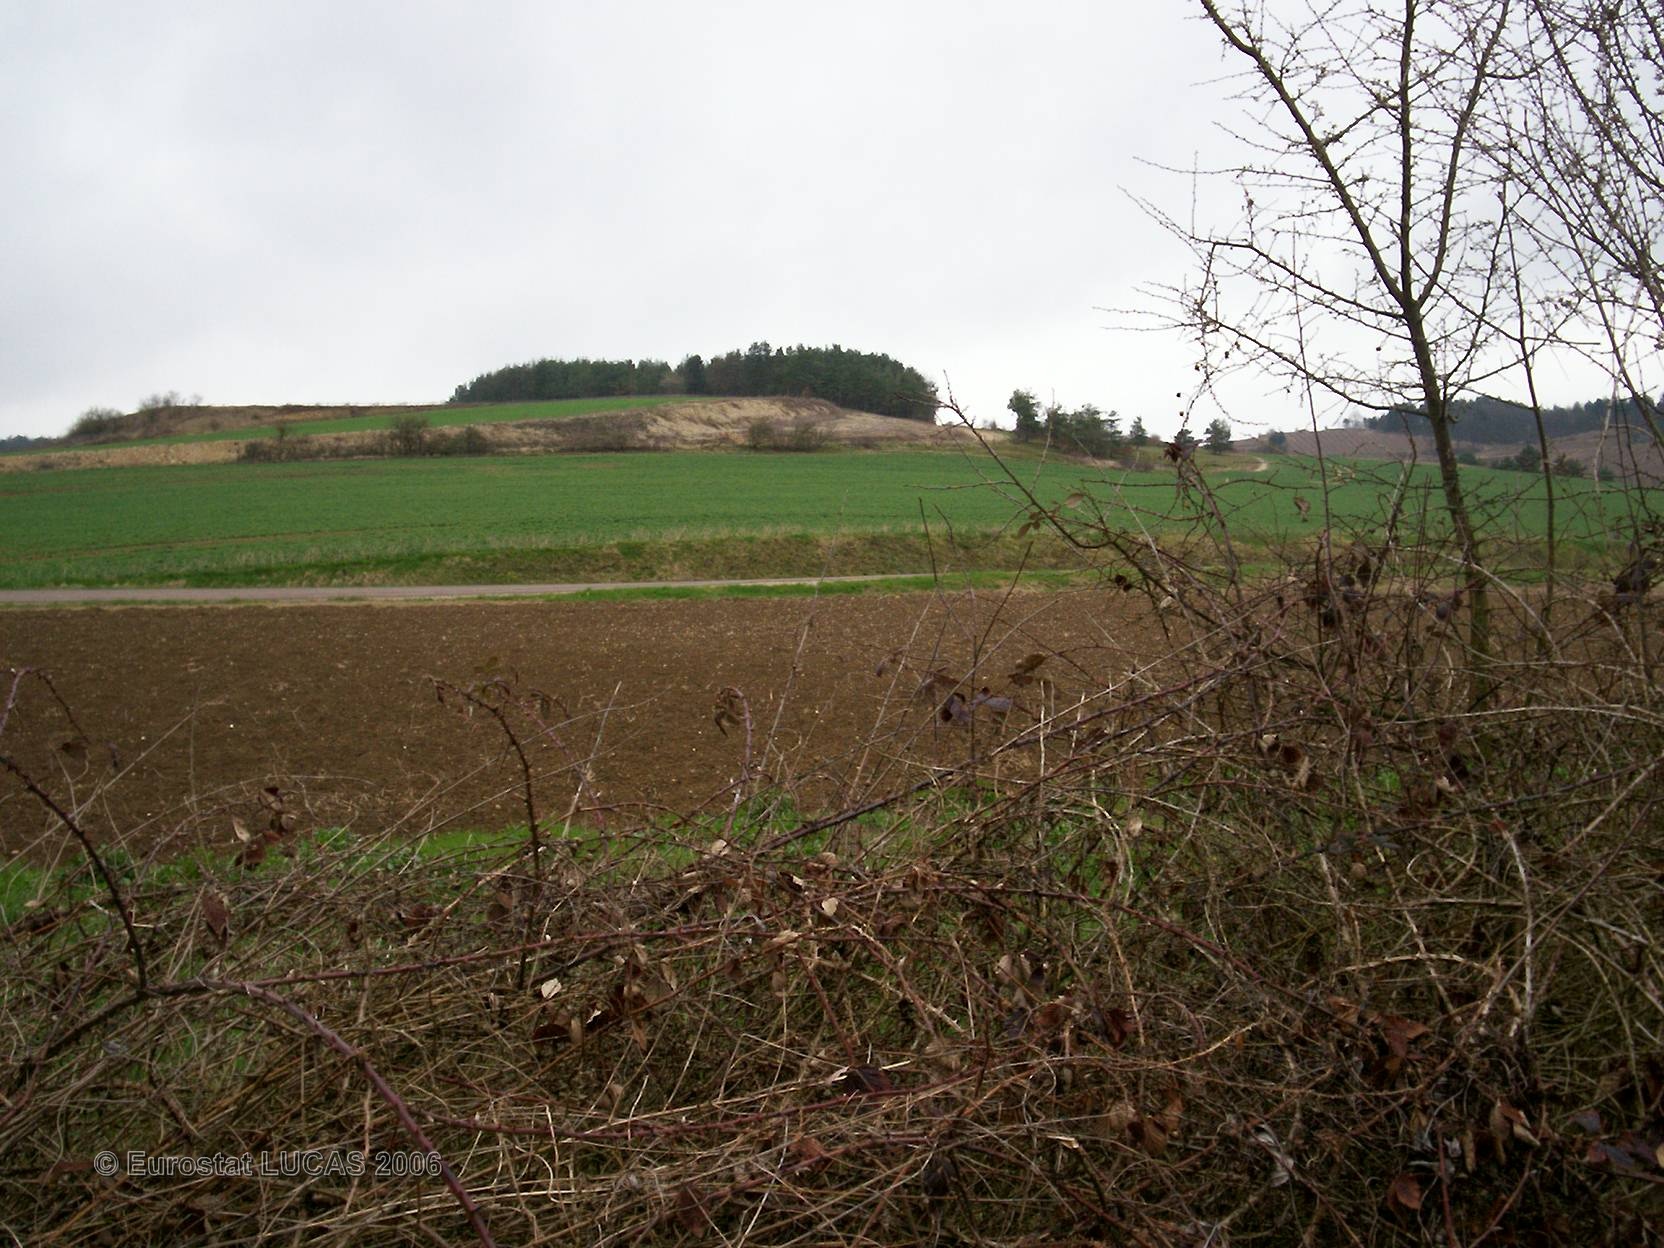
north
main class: Cropland
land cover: Common wheat
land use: Agriculture (excluding fallow land and kitchen gardens)
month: April
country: FR
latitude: 48.0853
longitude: 4.4803
